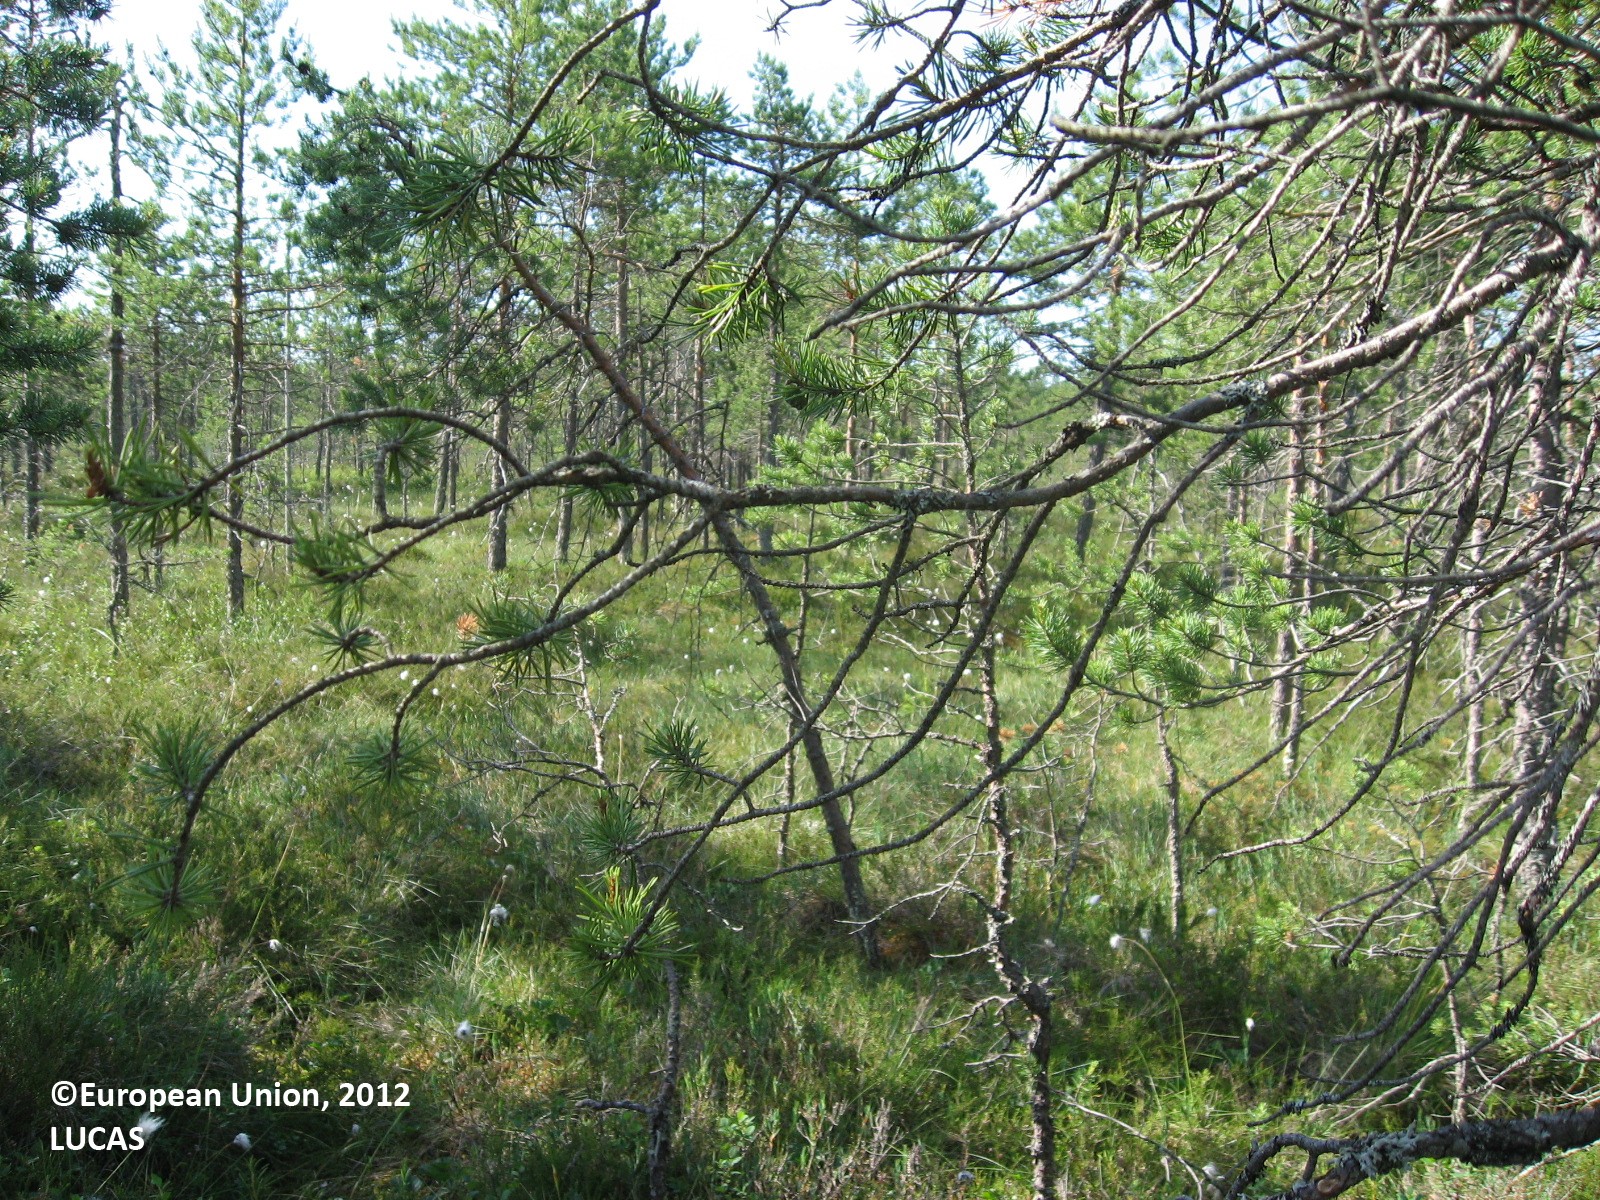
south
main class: Woodland
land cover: Pine dominated coniferous woodland
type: boreal forest
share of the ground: 25 - 50 %
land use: Forestry
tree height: < 5 m
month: July
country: FI
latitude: 60.8661
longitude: 26.4474
